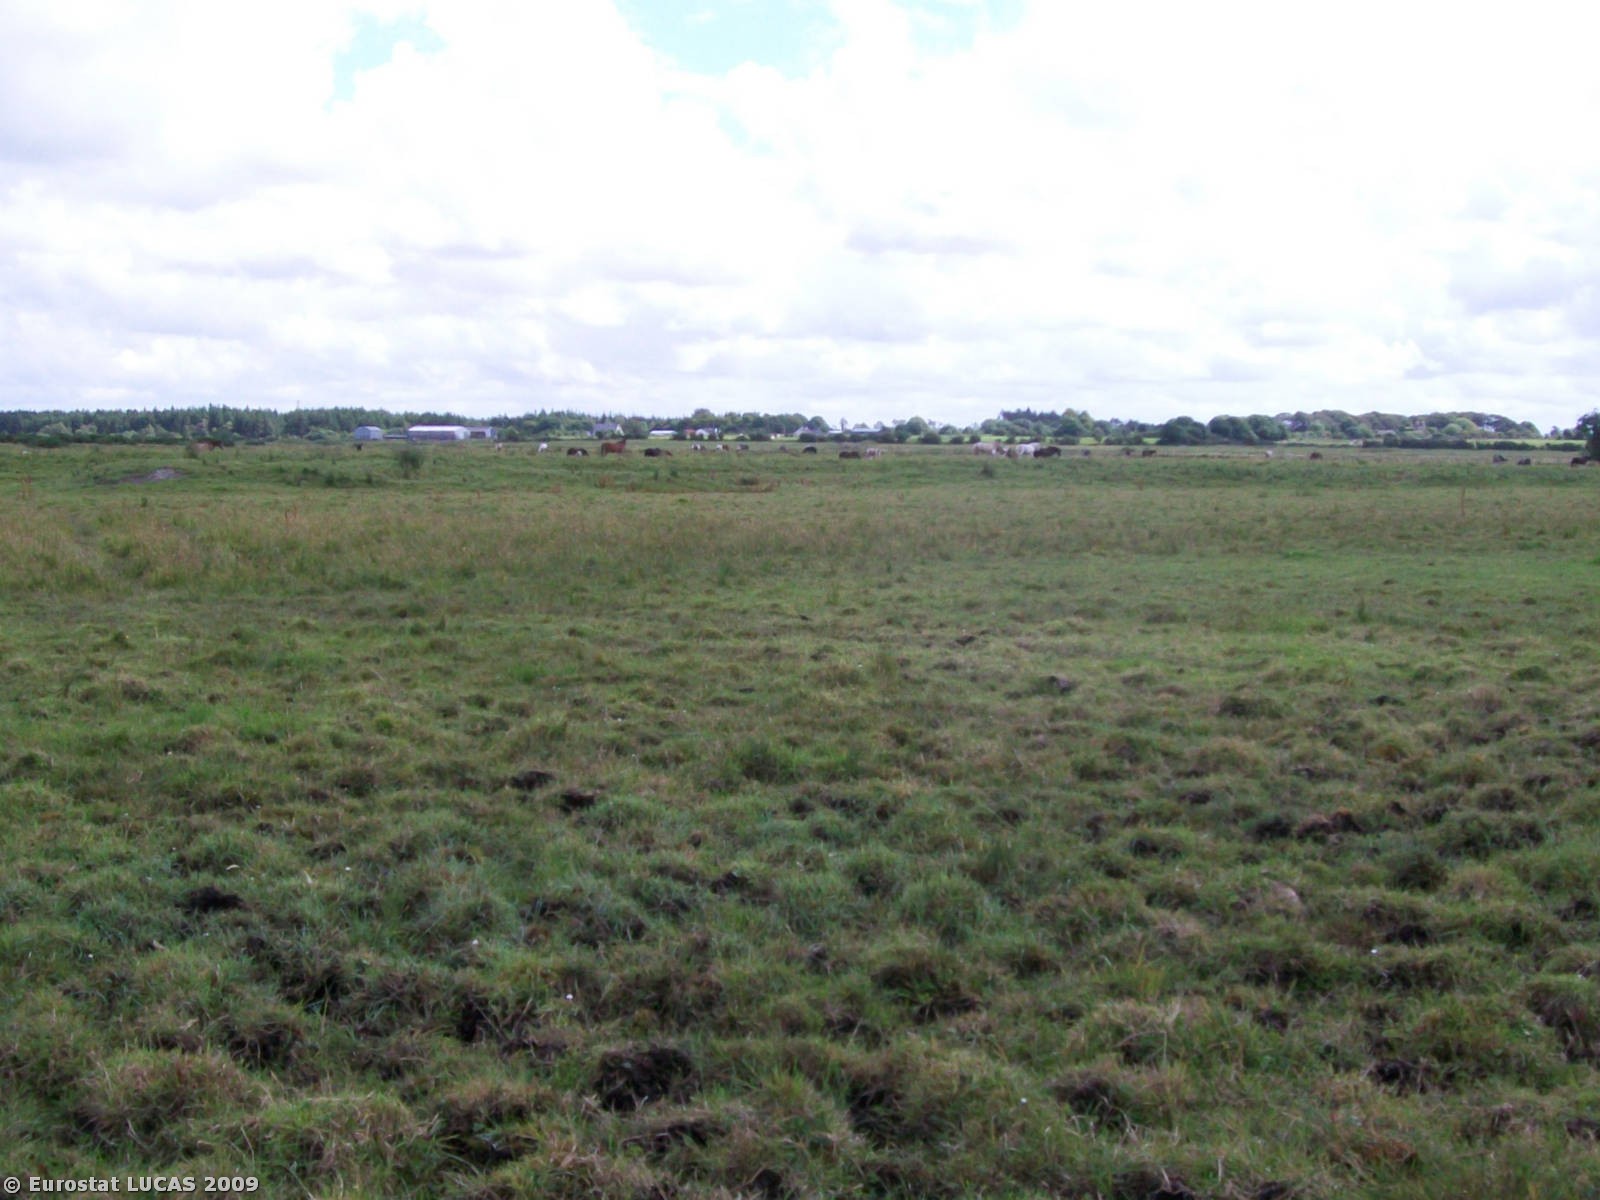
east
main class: Grassland
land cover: Grassland without tree/shrub cover
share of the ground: > 75 %
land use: Agriculture (excluding fallow land and kitchen gardens)
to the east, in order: Grassland without tree/shrub cover; Fences; Inland running water; Grassland without tree/shrub cover
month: July
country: IE
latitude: 53.4701
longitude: -8.8728
